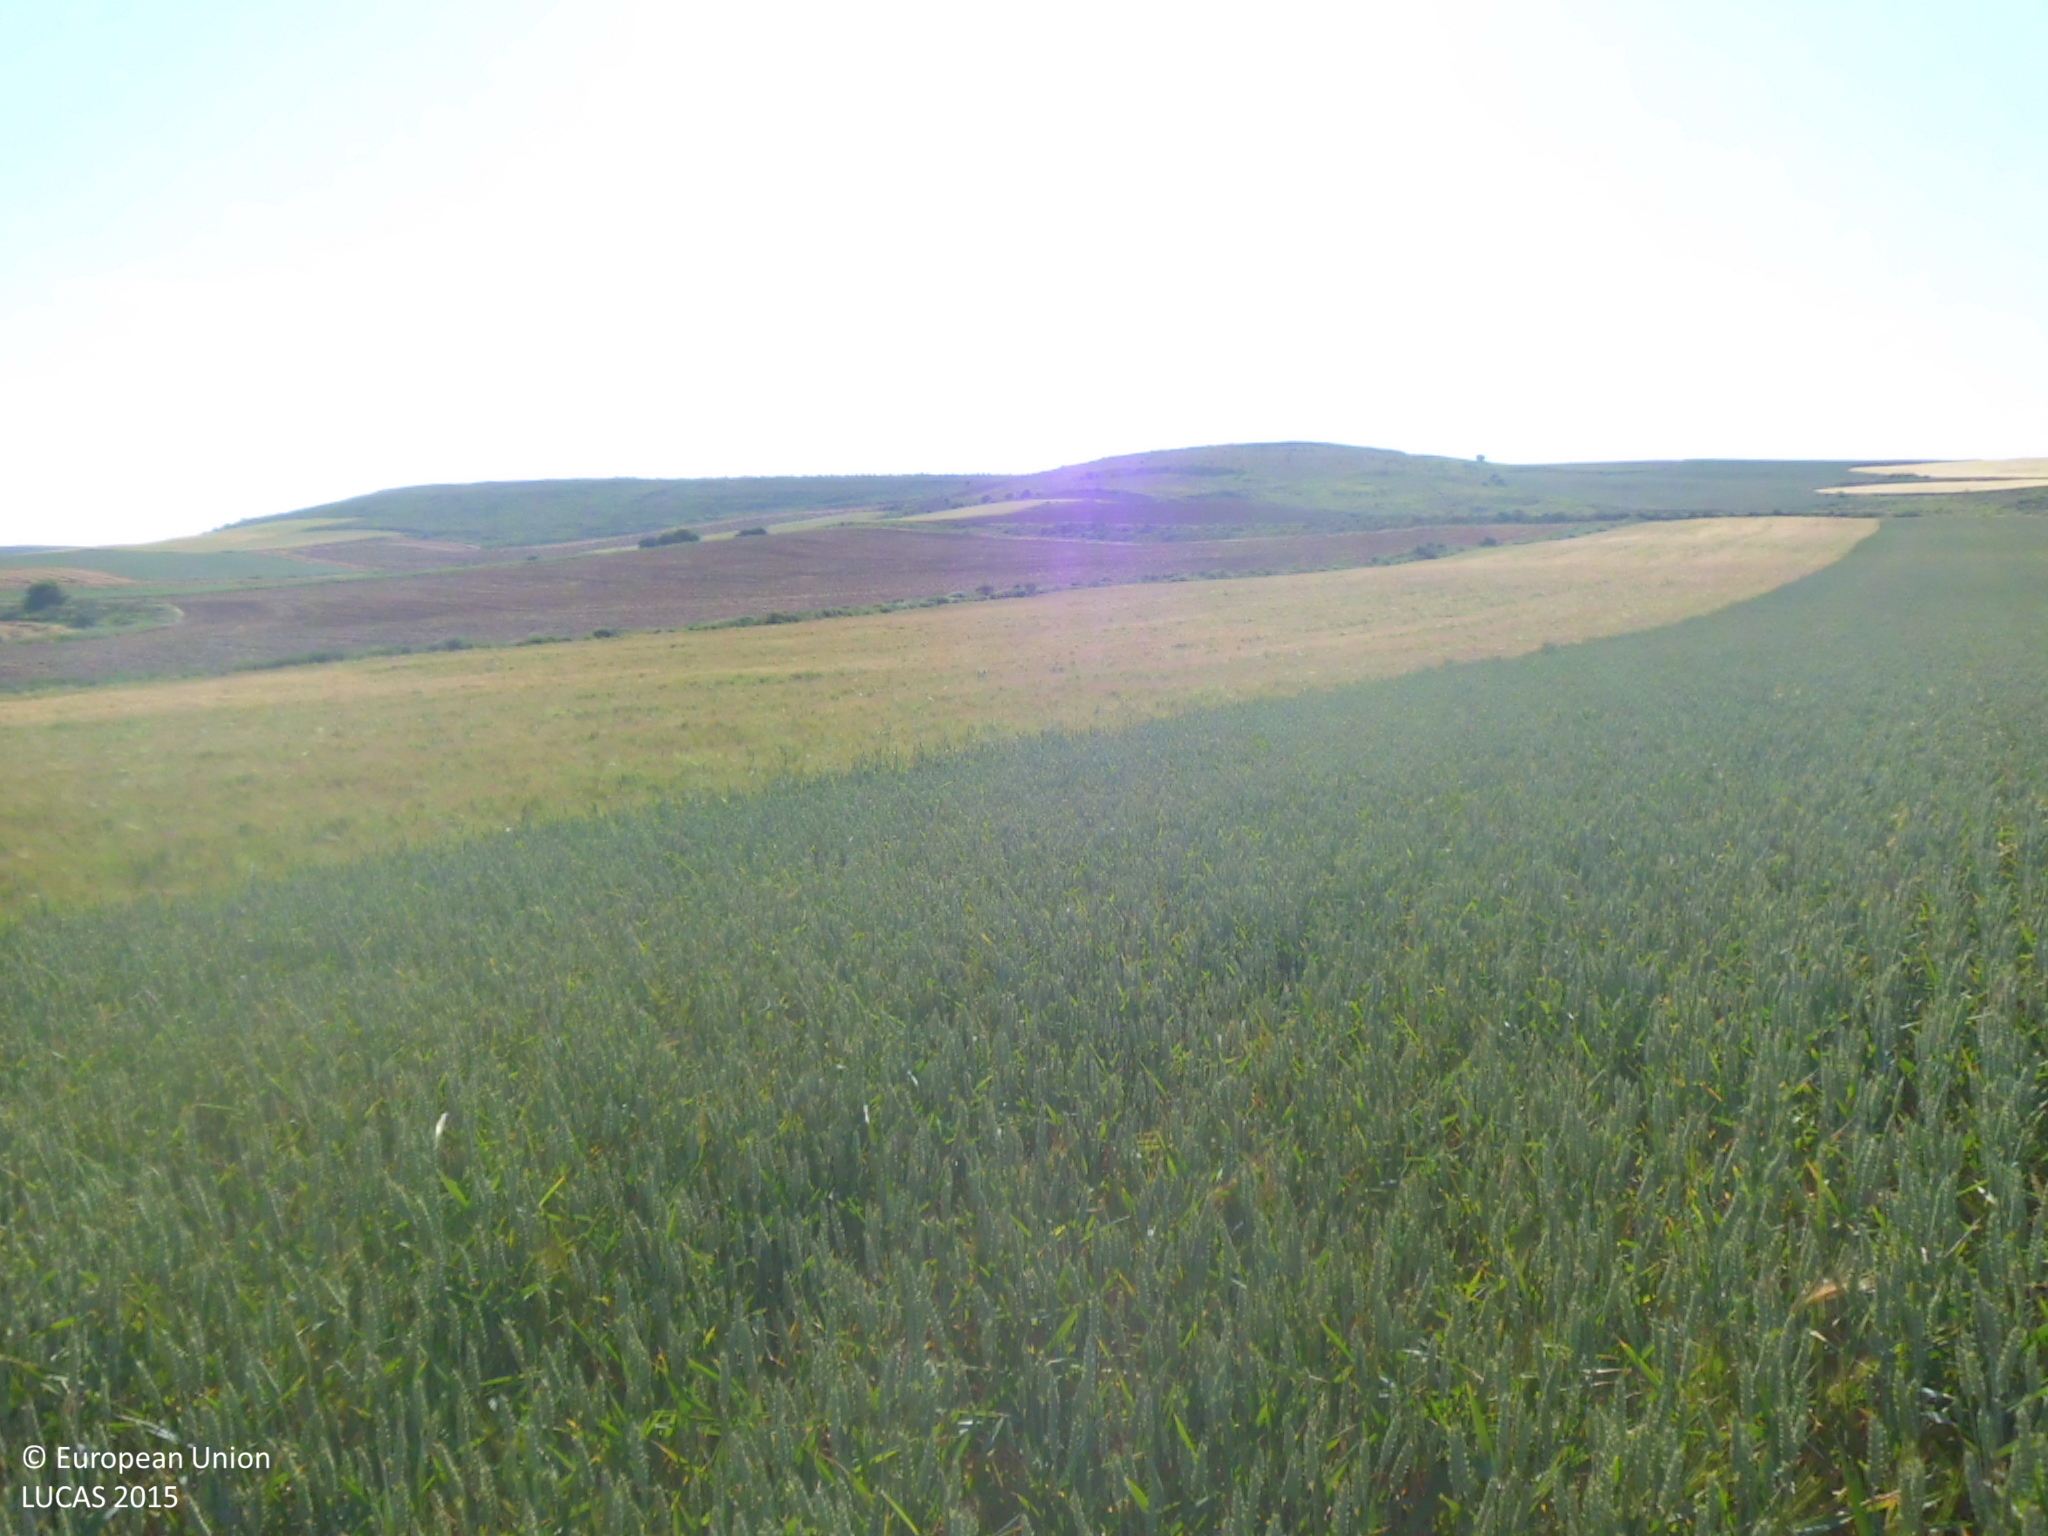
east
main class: Cropland
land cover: Common wheat
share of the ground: > 75 %
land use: Agriculture (excluding fallow land and kitchen gardens)
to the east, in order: Common wheat; Barley; Grass margins; Sunflower; Tracks; Grass margins; Sunflower
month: June
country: ES
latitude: 42.4644
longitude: -3.9915
